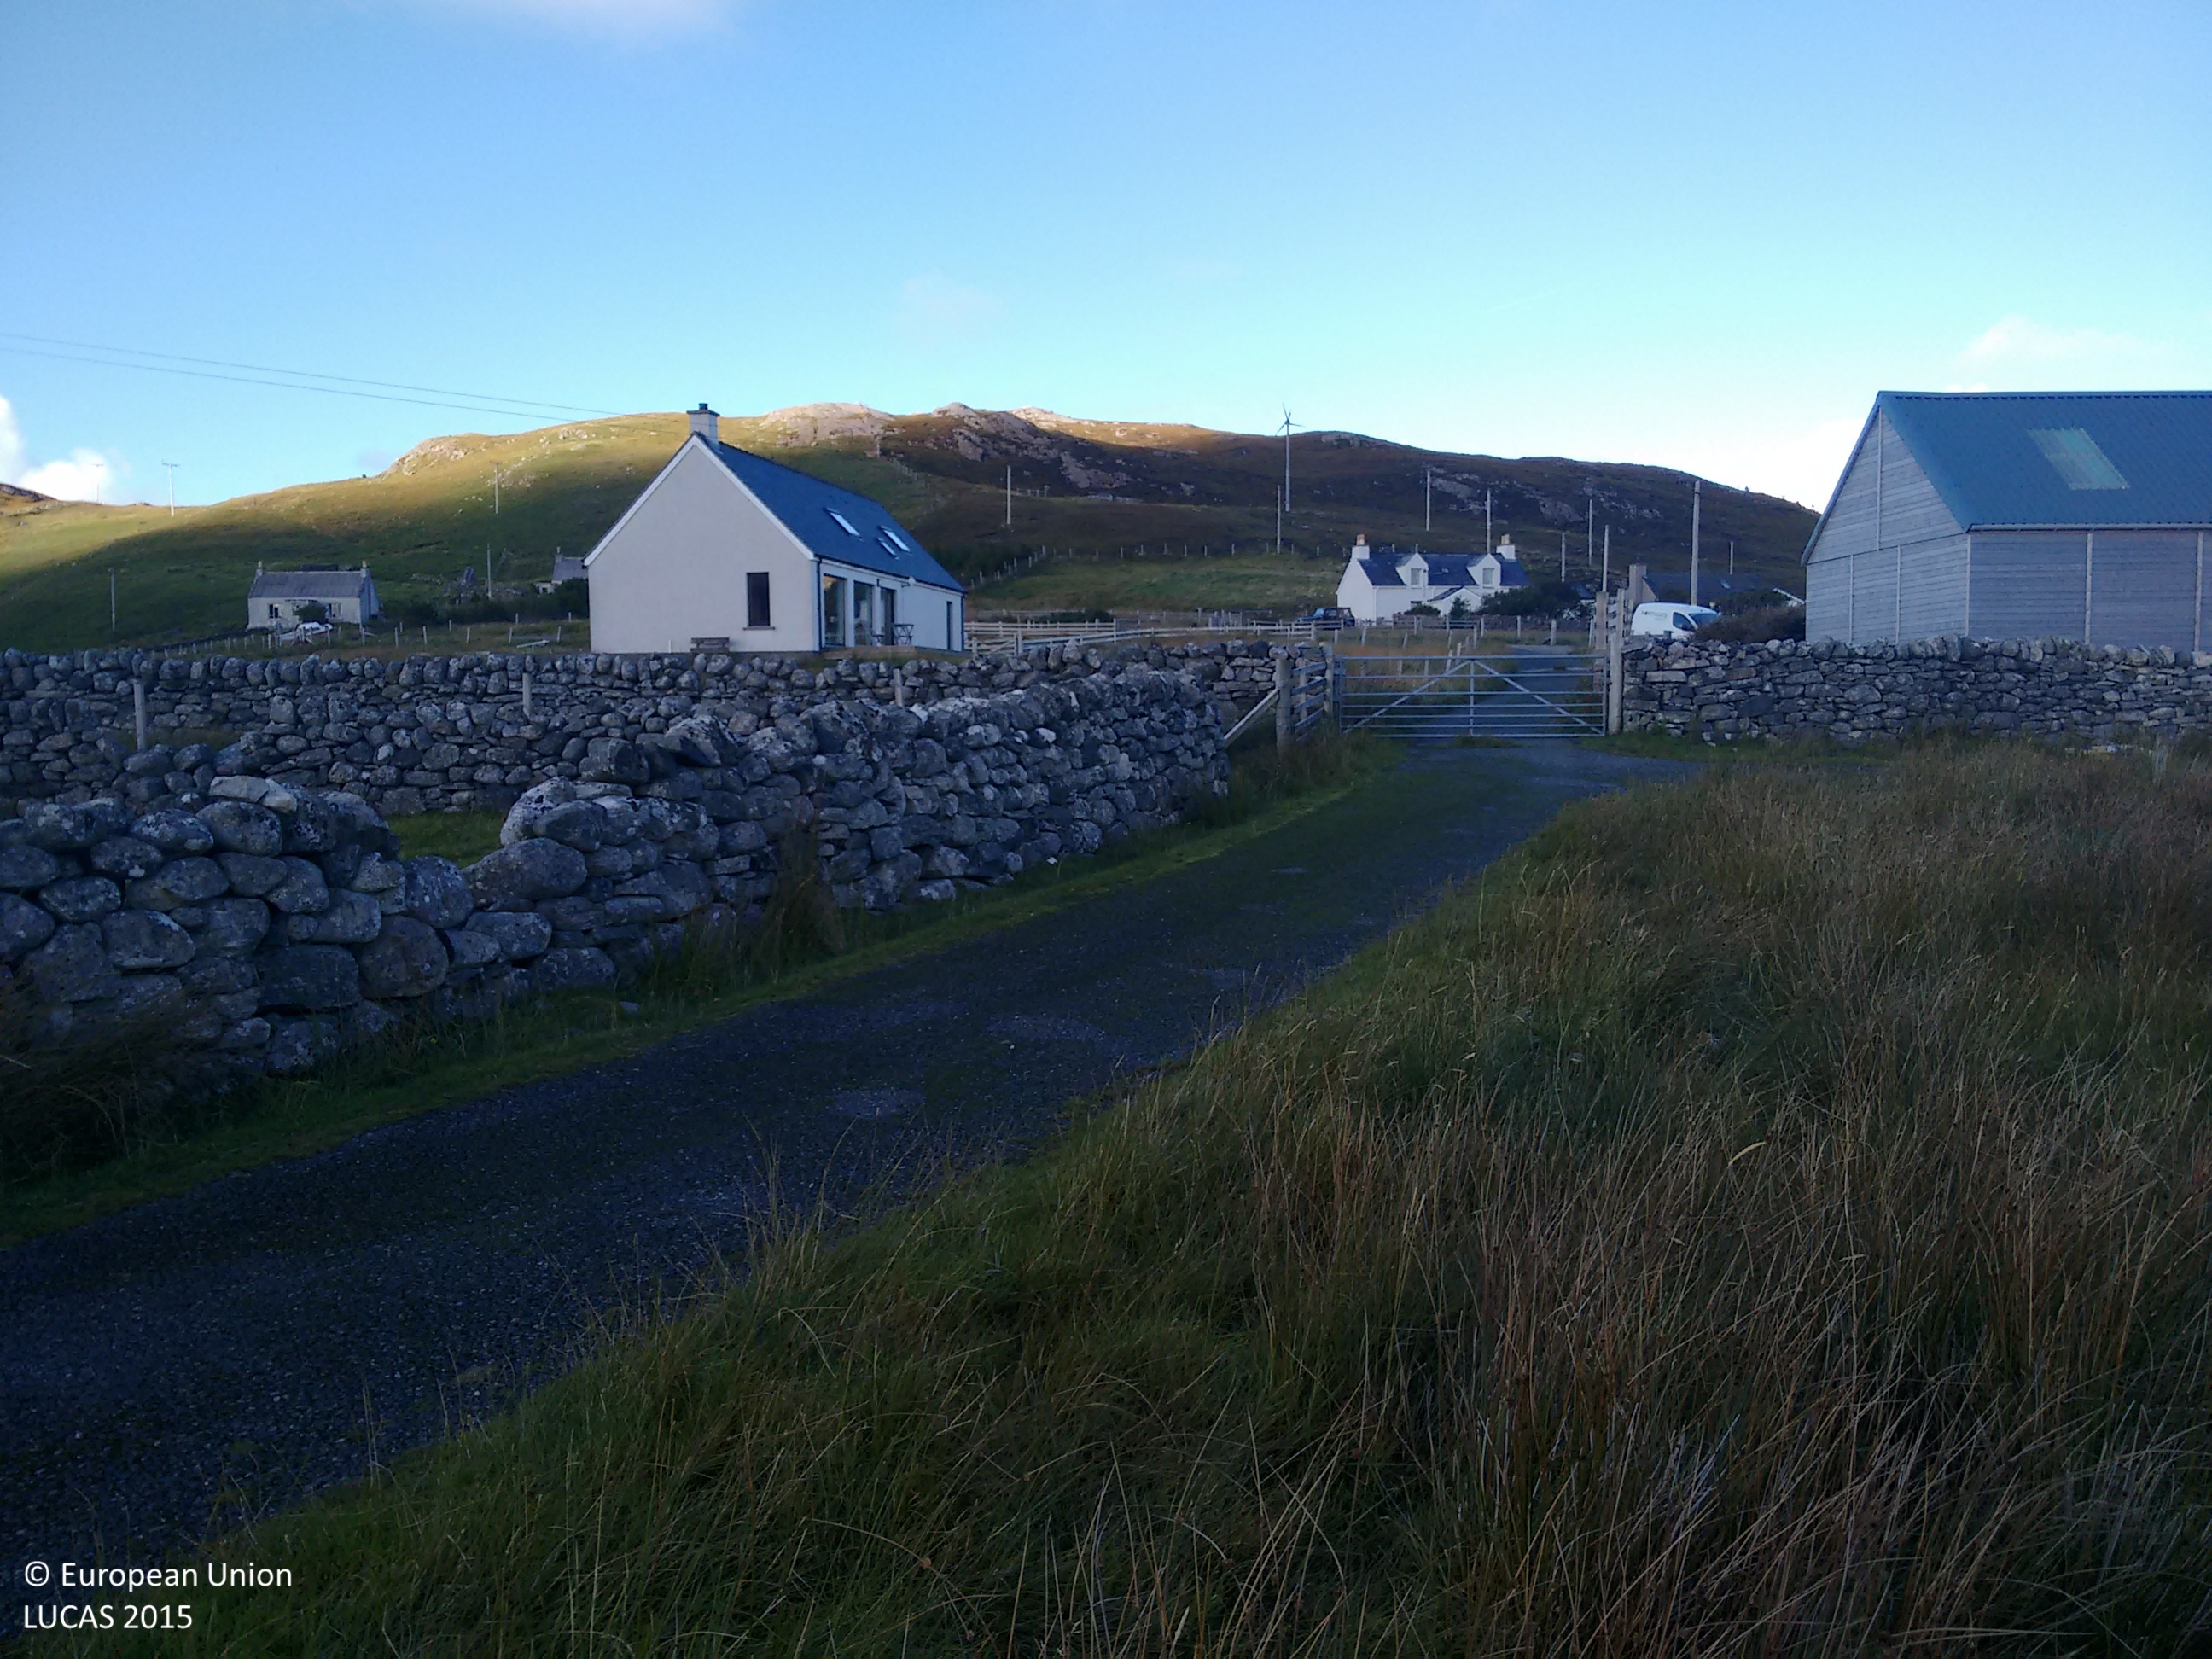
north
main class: Grassland
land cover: Grassland without tree/shrub cover
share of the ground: > 75 %
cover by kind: herbaceous plants 100 %
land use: Agriculture (excluding fallow land and kitchen gardens)
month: October
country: GB
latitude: 58.2012
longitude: -6.9452
